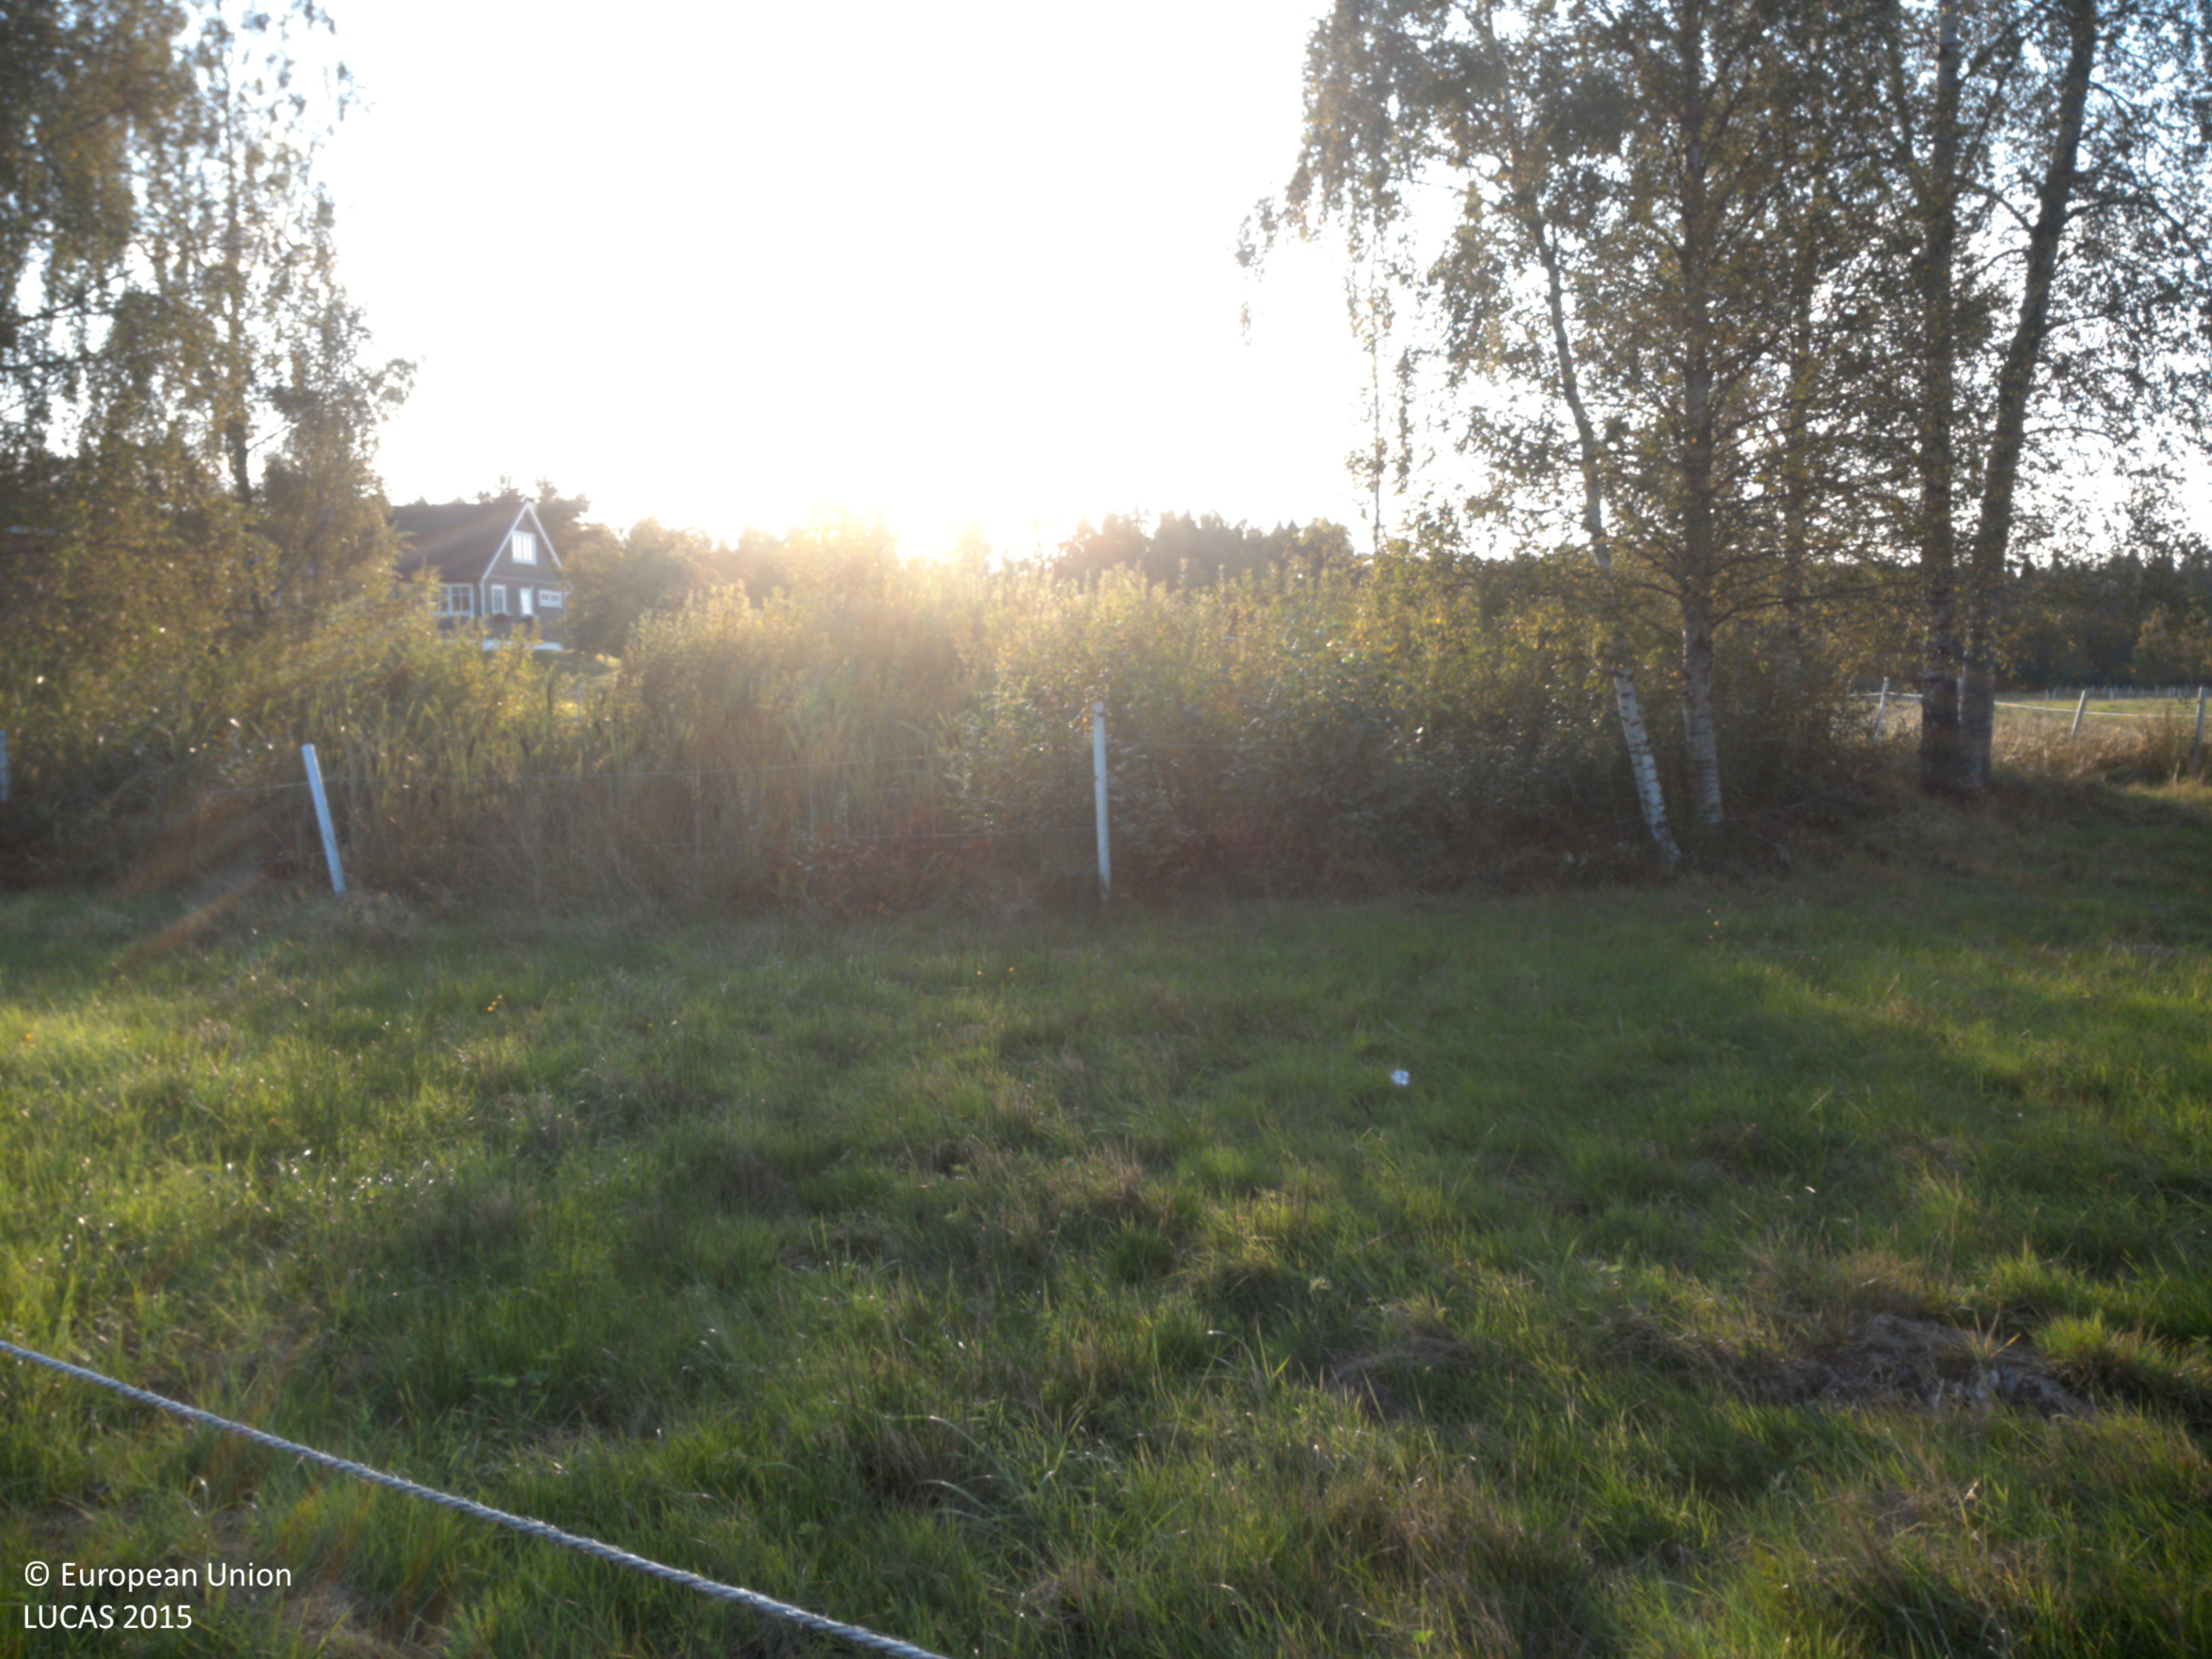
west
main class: Grassland
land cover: Grassland without tree/shrub cover
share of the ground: > 75 %
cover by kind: herbaceous plants 100 %
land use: Agriculture (excluding fallow land and kitchen gardens)
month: August
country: SE
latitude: 58.4707
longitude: 12.2415
